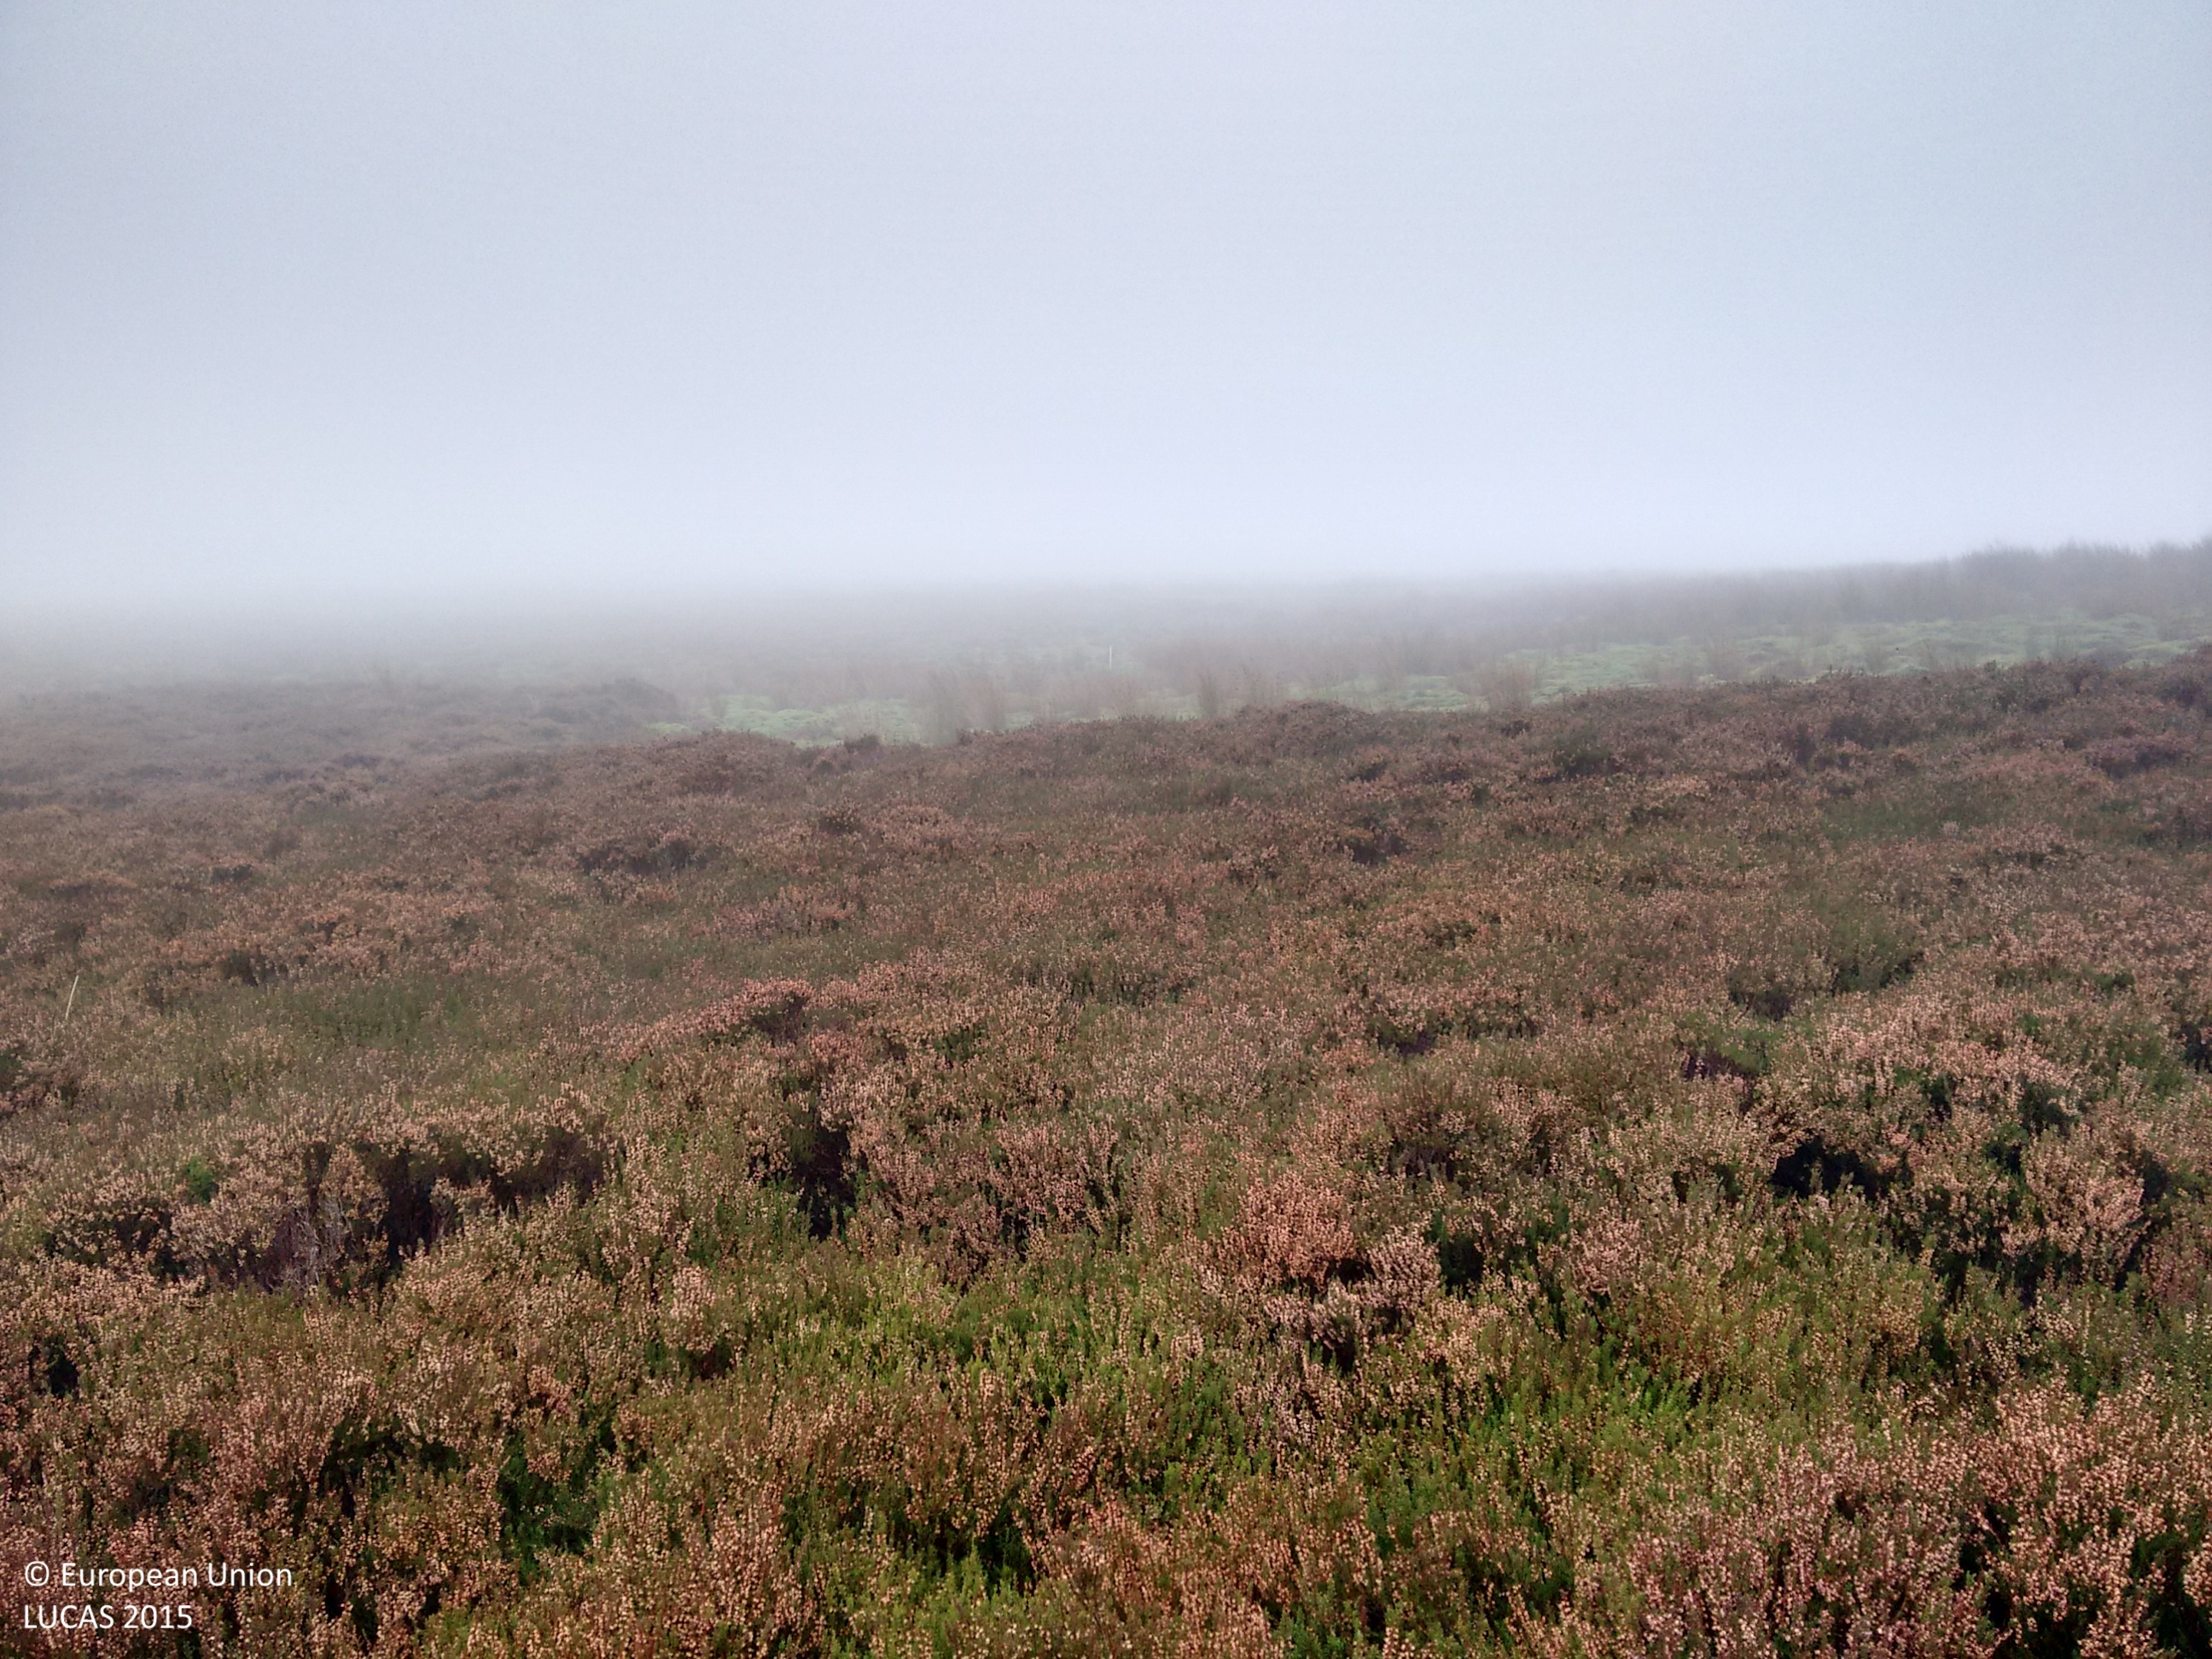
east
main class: Shrubland
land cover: Shrubland without tree cover
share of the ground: > 75 %
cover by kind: shrubs 80 %, herbaceous plants 20 %
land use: Semi-natural and natural areas not in use
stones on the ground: < 10 %
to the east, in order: Shrubland without tree cover; Grass margins; Tracks; Grass margins; Shrubland without tree cover
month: October
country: GB
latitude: 54.4654
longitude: -2.1071
